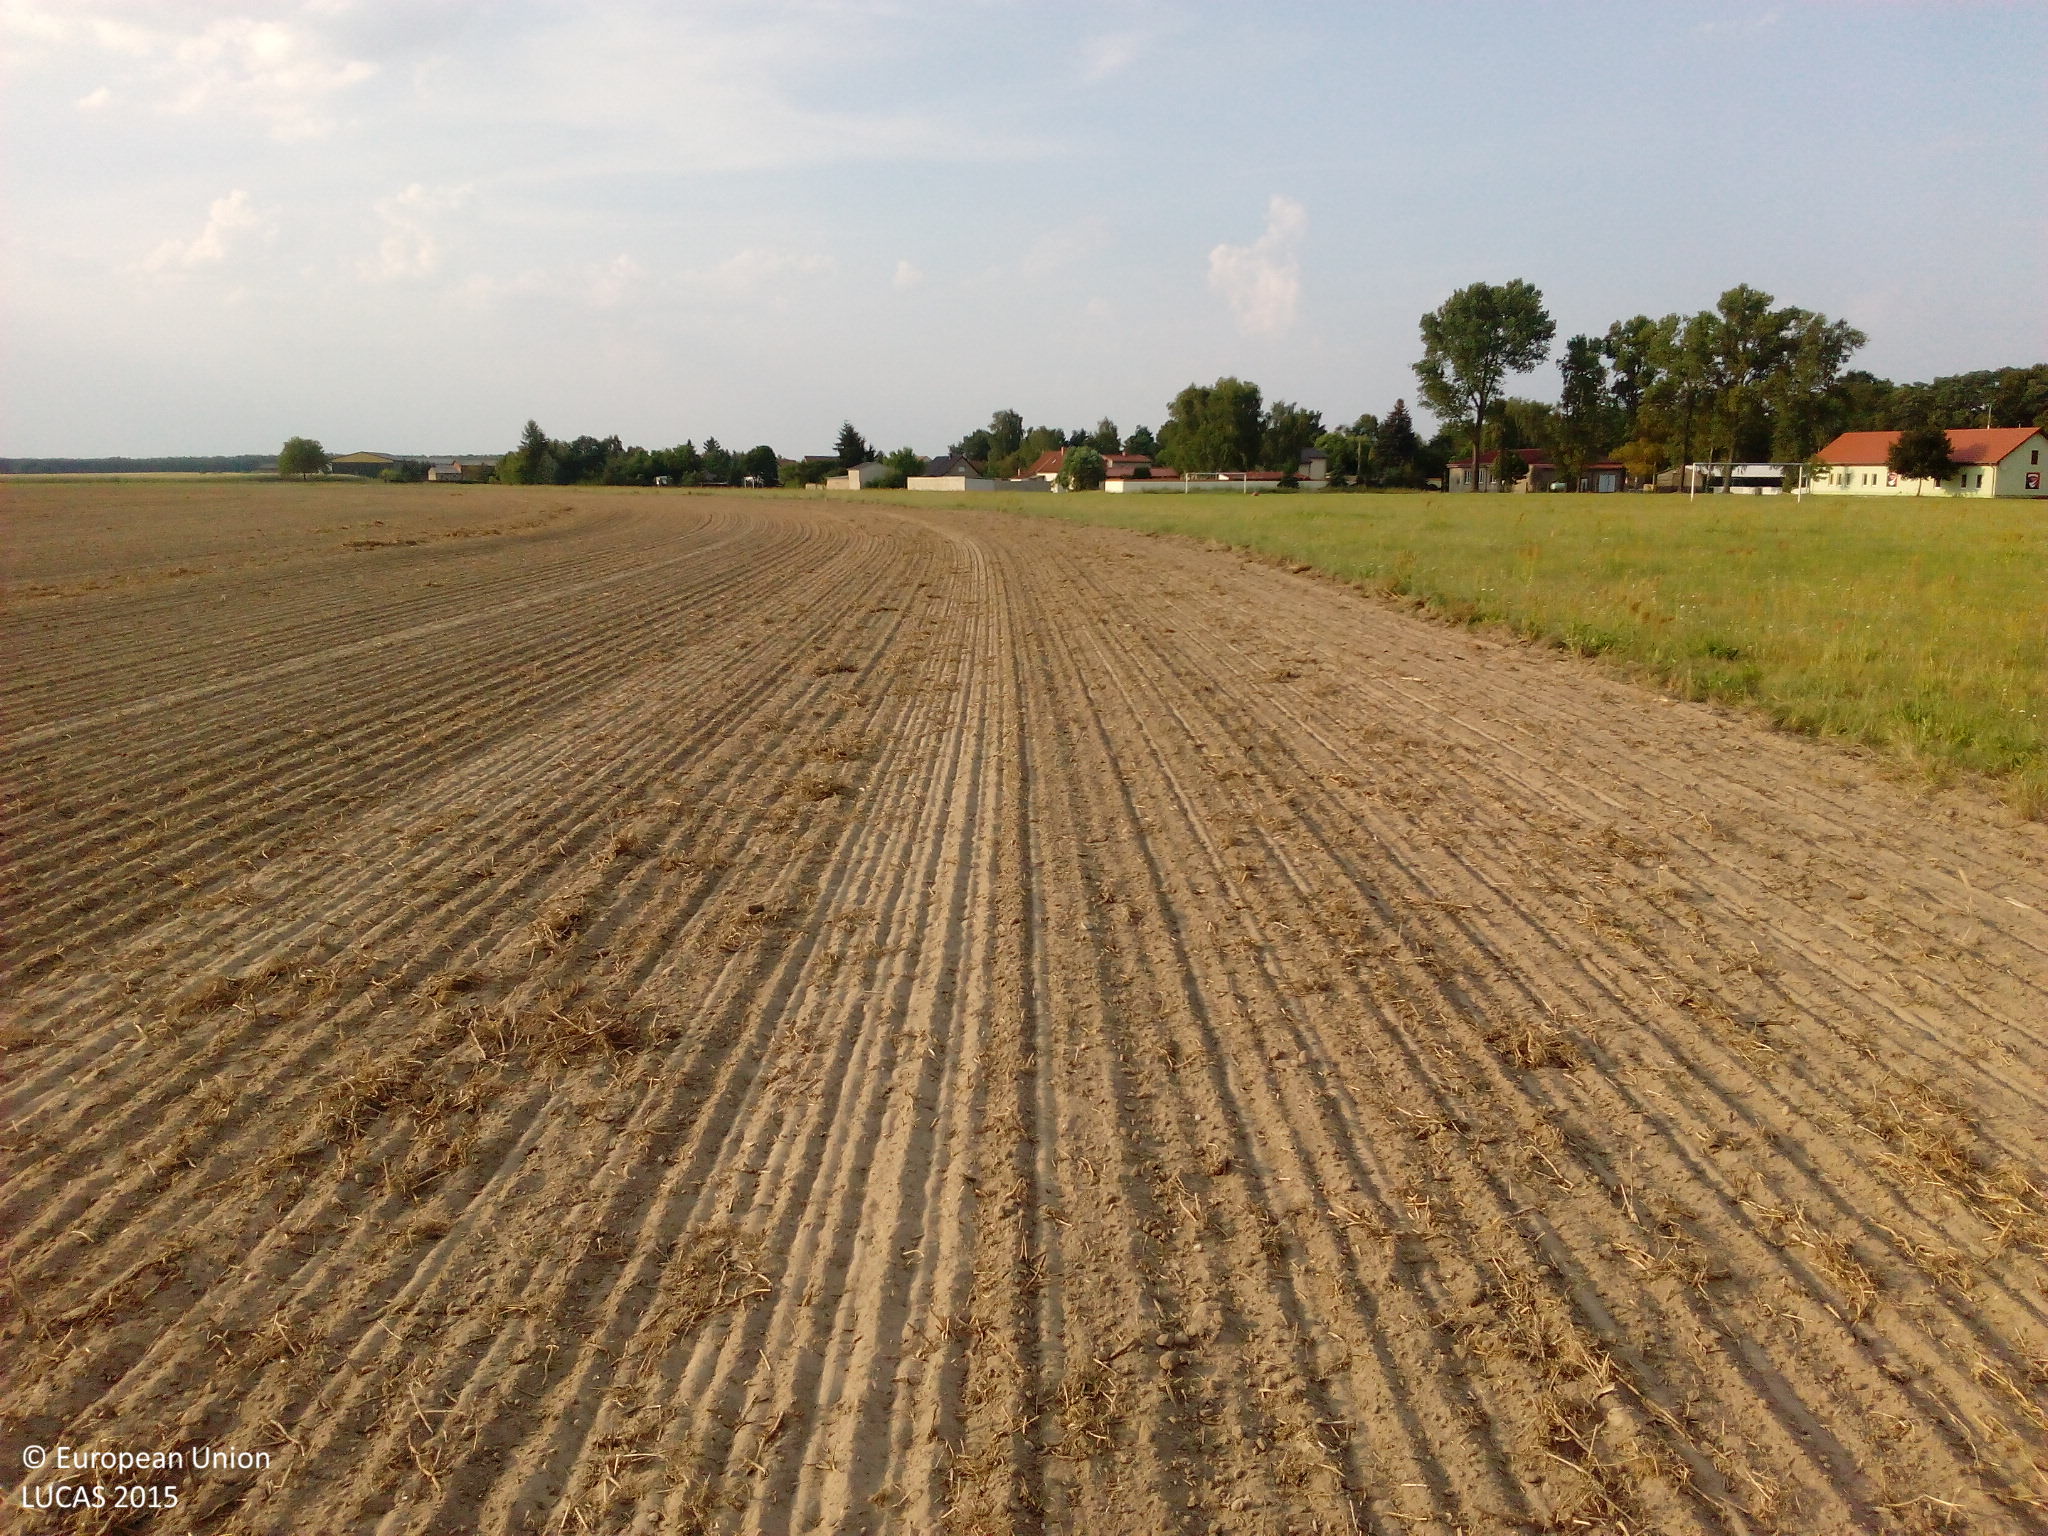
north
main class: Cropland
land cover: Dry pulses
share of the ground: < 10 %
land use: Agriculture (excluding fallow land and kitchen gardens)
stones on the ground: < 10 %
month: August
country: DE
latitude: 51.8882
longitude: 13.0657
